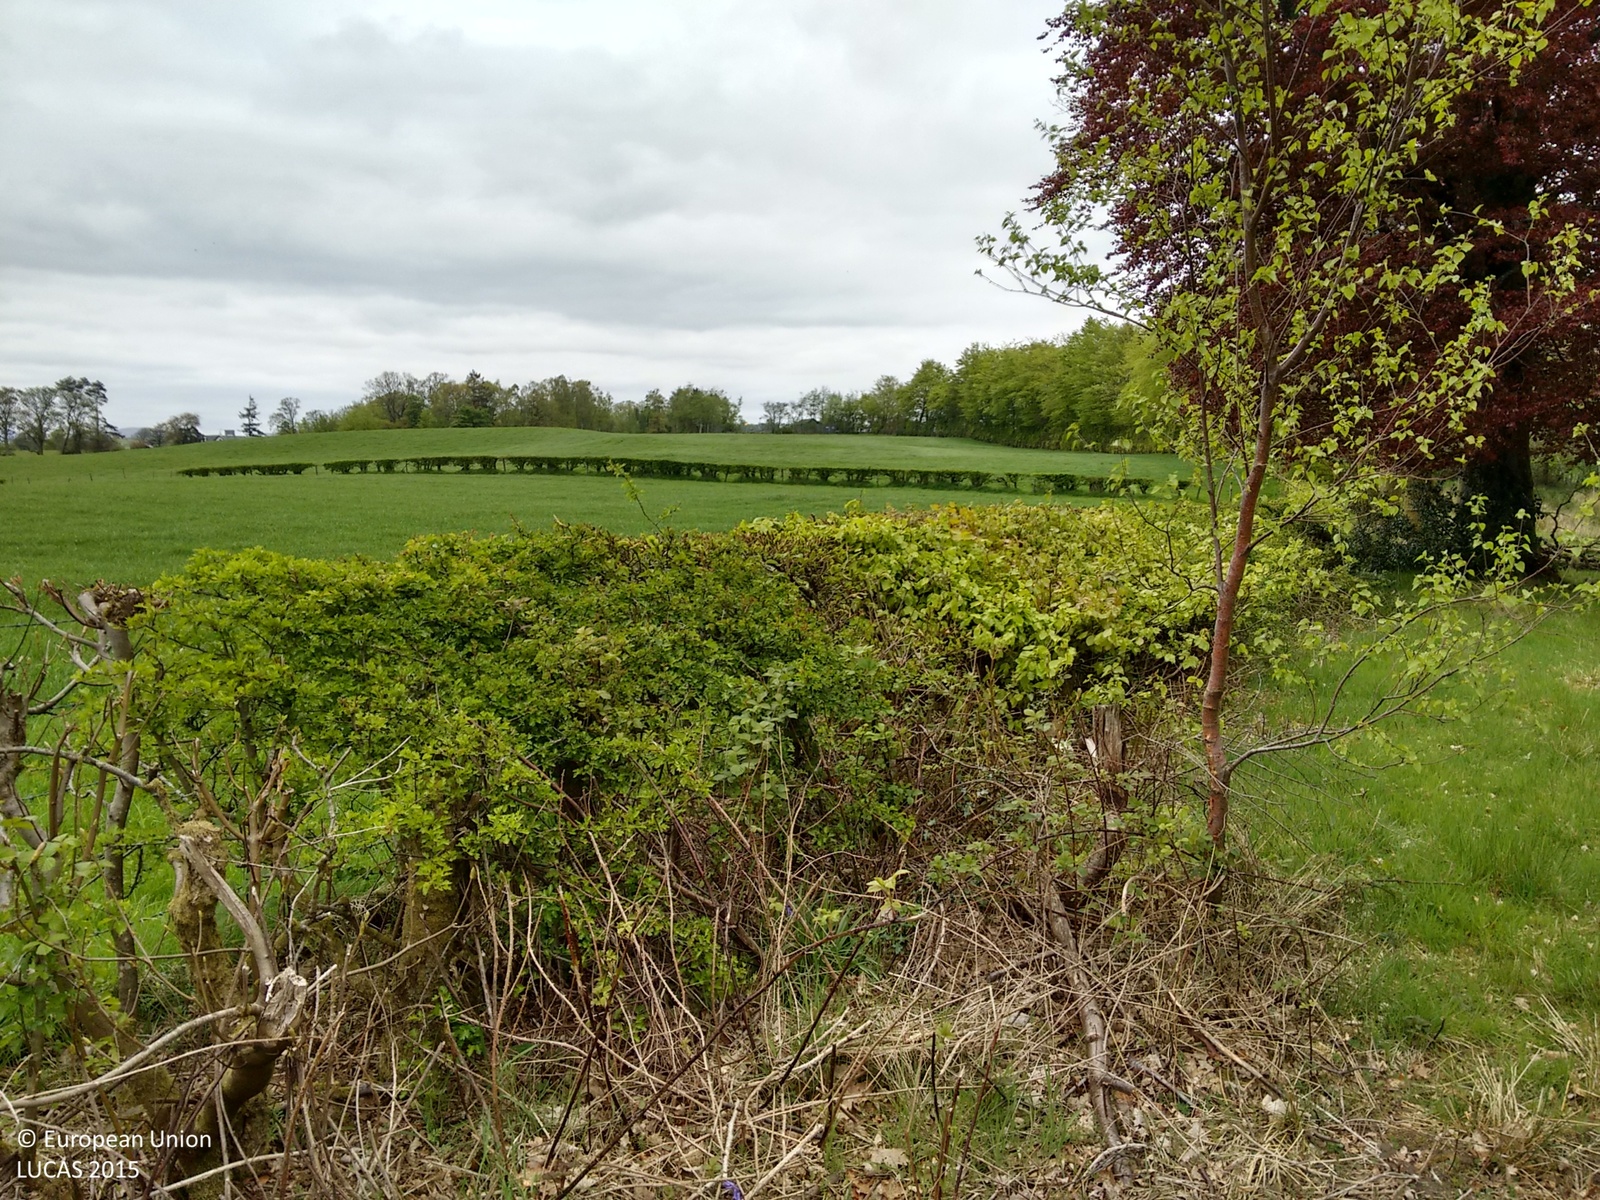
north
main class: Grassland
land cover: Grassland without tree/shrub cover
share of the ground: > 75 %
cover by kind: herbaceous plants 90 %, shrubs 5 %, unconsolidated bare surface 5 %
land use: Semi-natural and natural areas not in use
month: May
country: GB
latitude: 56.0111
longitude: -4.5507
